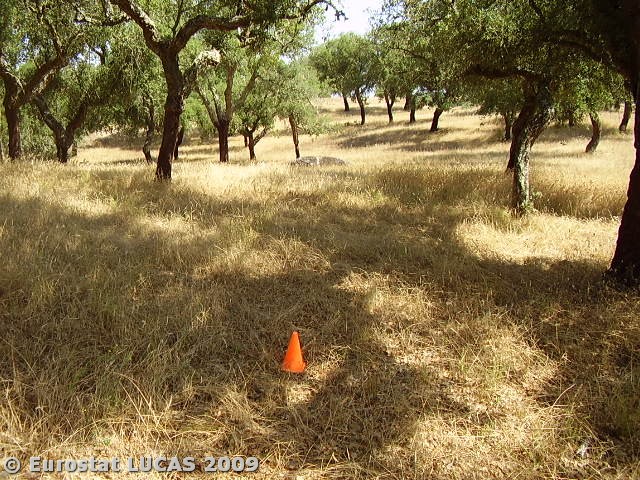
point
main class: Woodland
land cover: Broadleaved woodland
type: broadleaved evergreen forest
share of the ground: 50 - 75 %
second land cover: Spontaneously vegetated surfaces
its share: 25 - 50 %
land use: Forestry
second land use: Fallow land
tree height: > 5 m
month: June
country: PT
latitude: 38.7738
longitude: -7.9896
